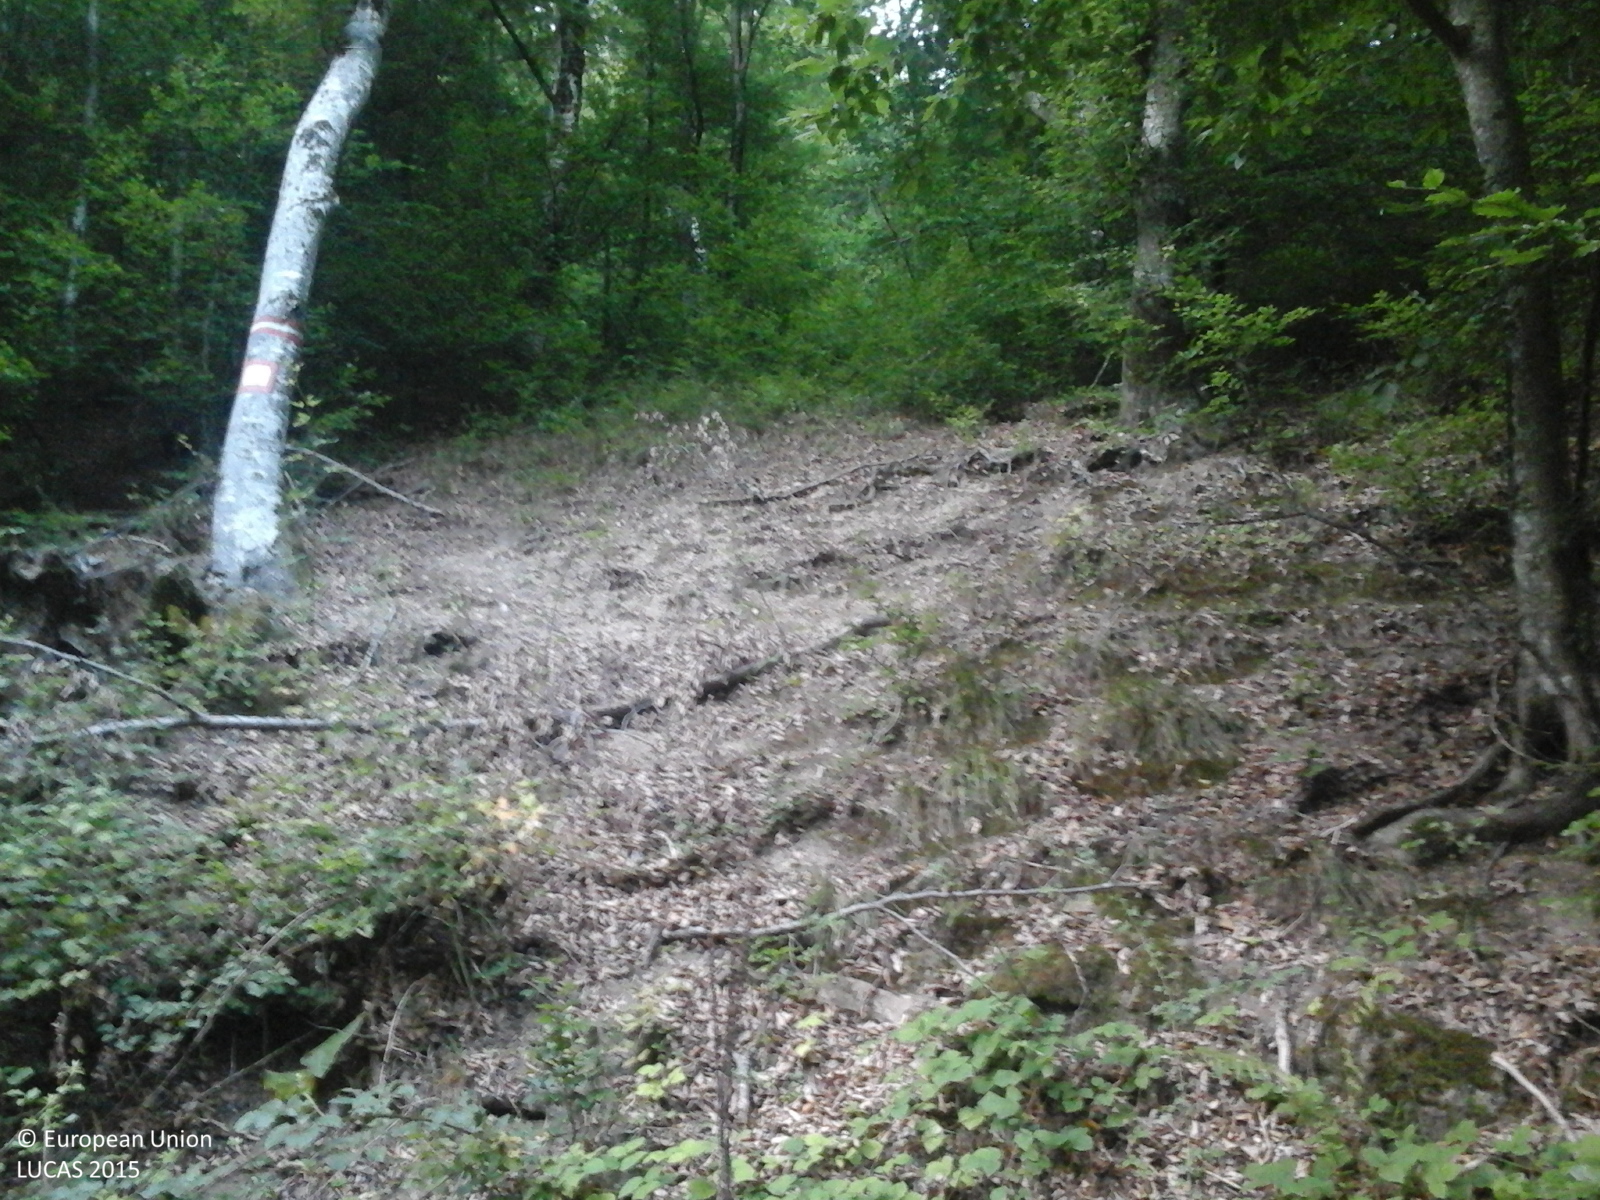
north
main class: Grassland
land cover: Spontaneously vegetated surfaces
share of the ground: > 75 %
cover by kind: herbaceous plants 100 %
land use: Forestry
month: August
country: RO
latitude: 46.4636
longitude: 22.2488
